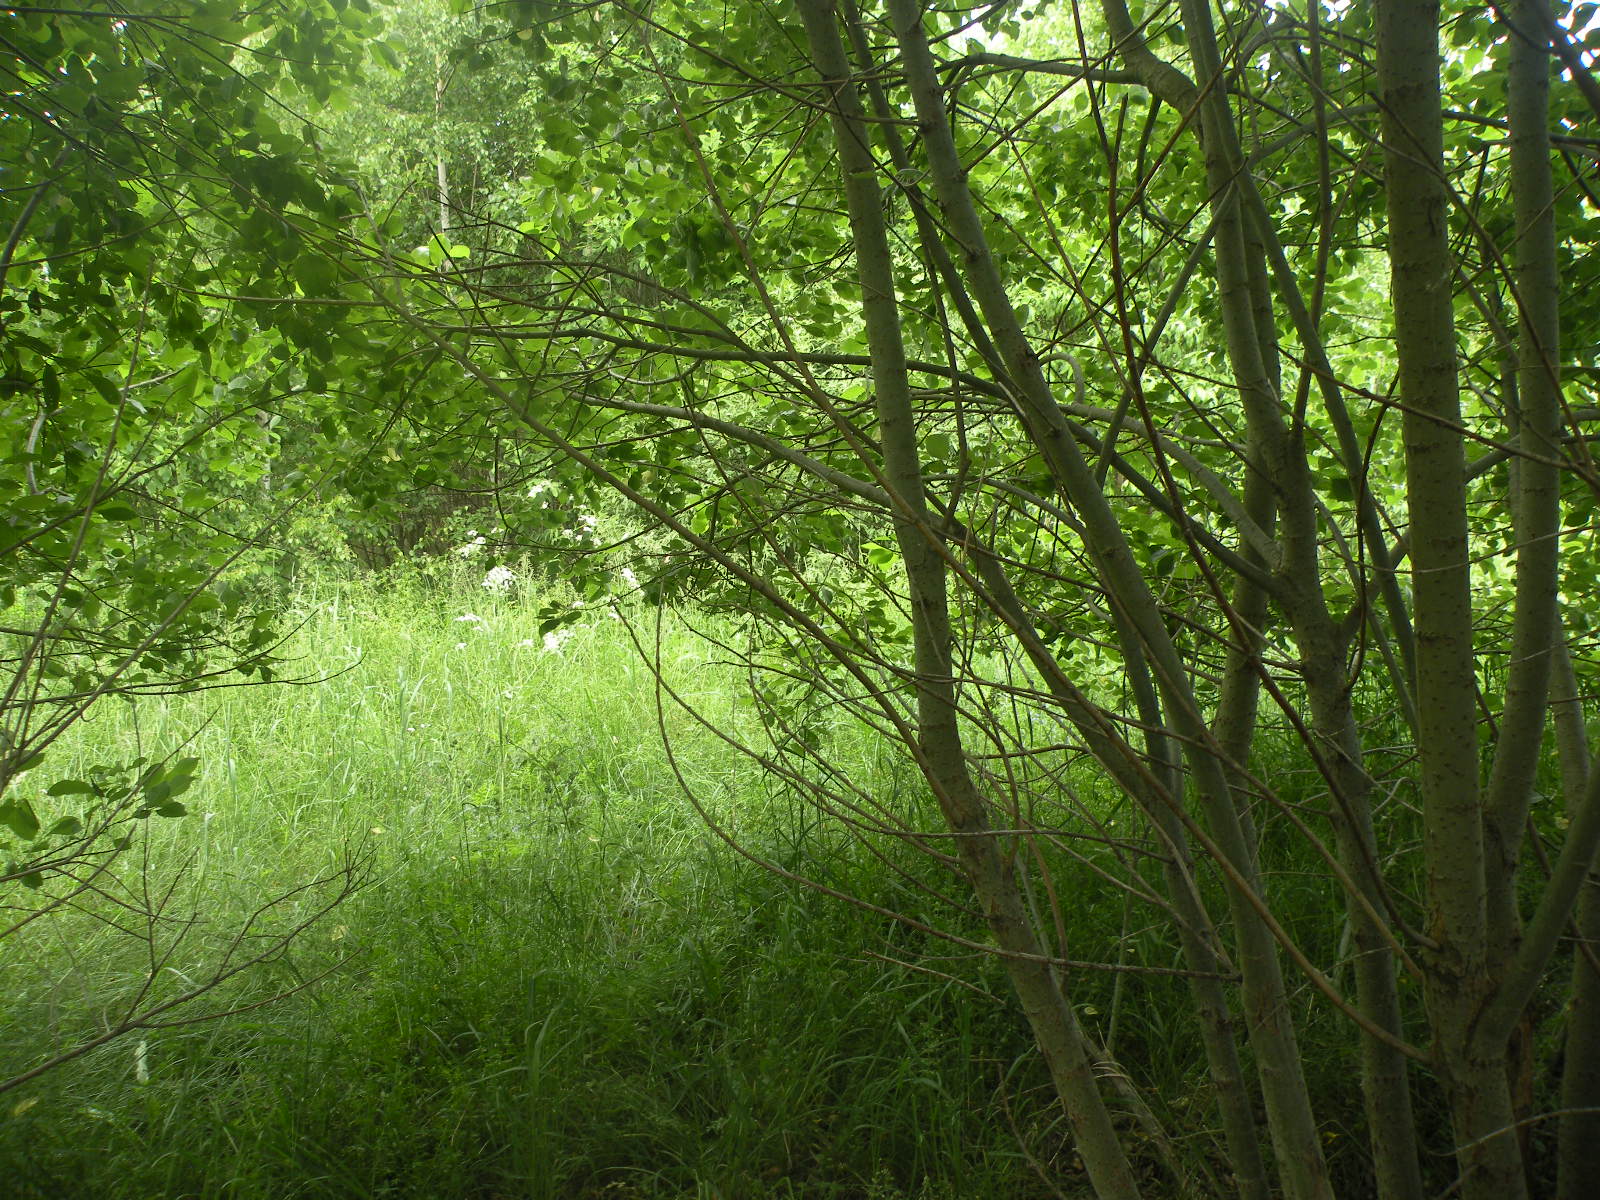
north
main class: Woodland
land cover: Broadleaved woodland
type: non-riverine alder, birch or aspen forest
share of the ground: > 75 %
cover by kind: broadleaved forest trees 95 %, herbaceous plants 5 %
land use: Forestry
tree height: < 5 m
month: June
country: LV
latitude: 55.9687
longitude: 26.6739
